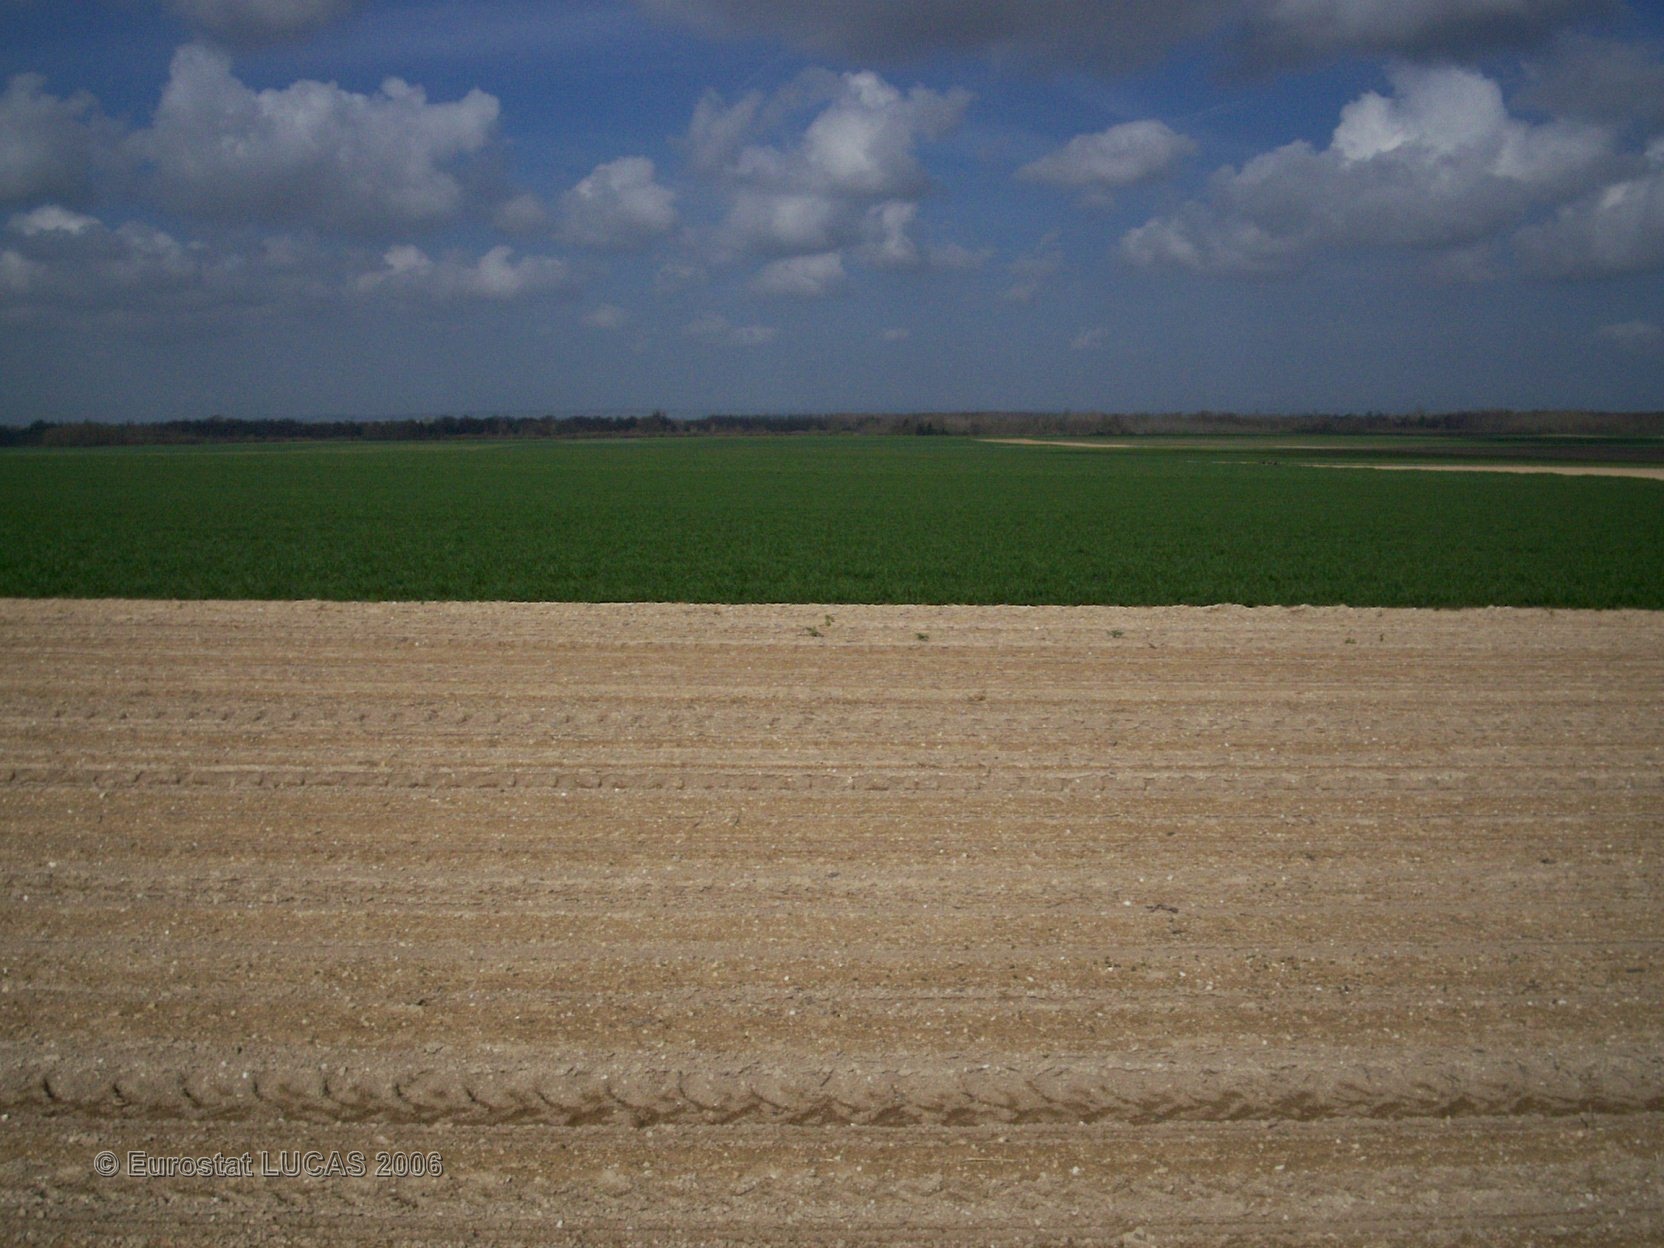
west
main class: Cropland
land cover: Sugar beet
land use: Agriculture (excluding fallow land and kitchen gardens)
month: May
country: FR
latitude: 48.5978
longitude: 3.9342
